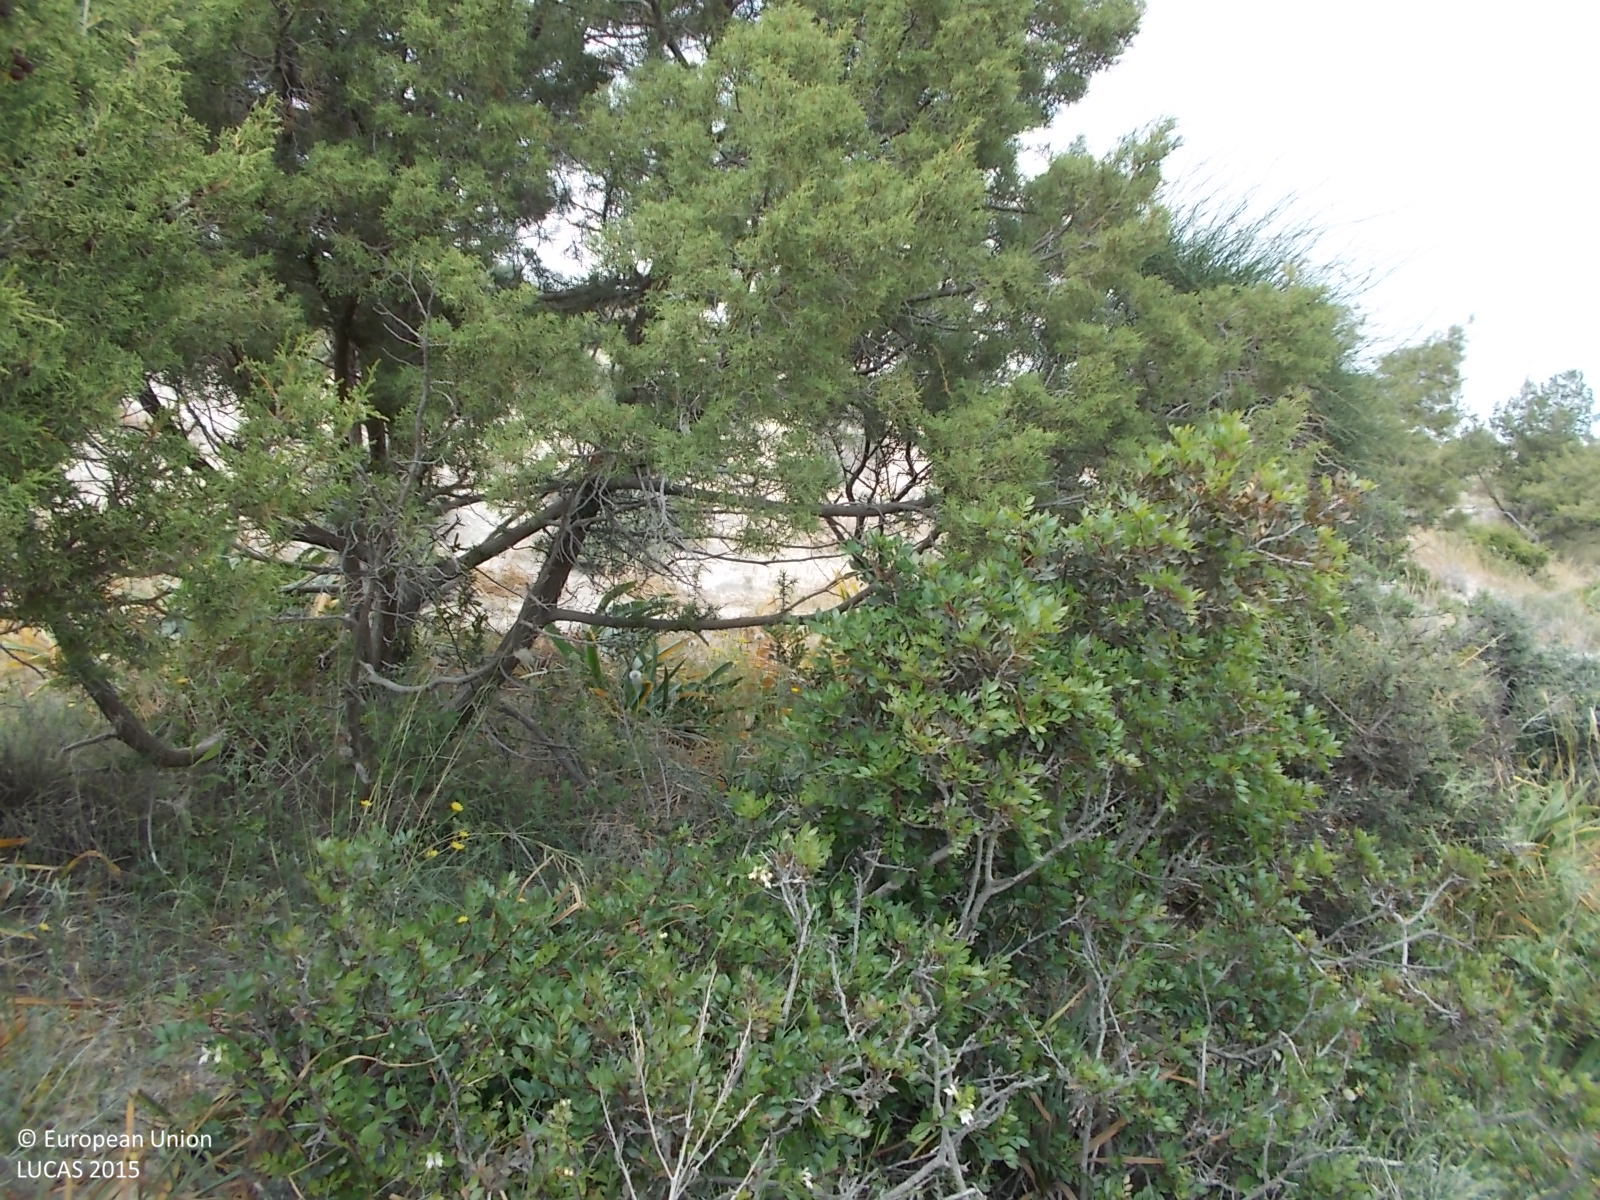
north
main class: Shrubland
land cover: Shrubland with sparse tree cover
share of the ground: 50 - 75 %
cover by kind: shrubs 50 %, unconsolidated bare surface 35 %, herbaceous plants 10 %, coniferous forest trees 5 %
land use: Semi-natural and natural areas not in use
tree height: < 5 m
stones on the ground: < 10 %
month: May
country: CY
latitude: 34.7414
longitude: 33.2771
